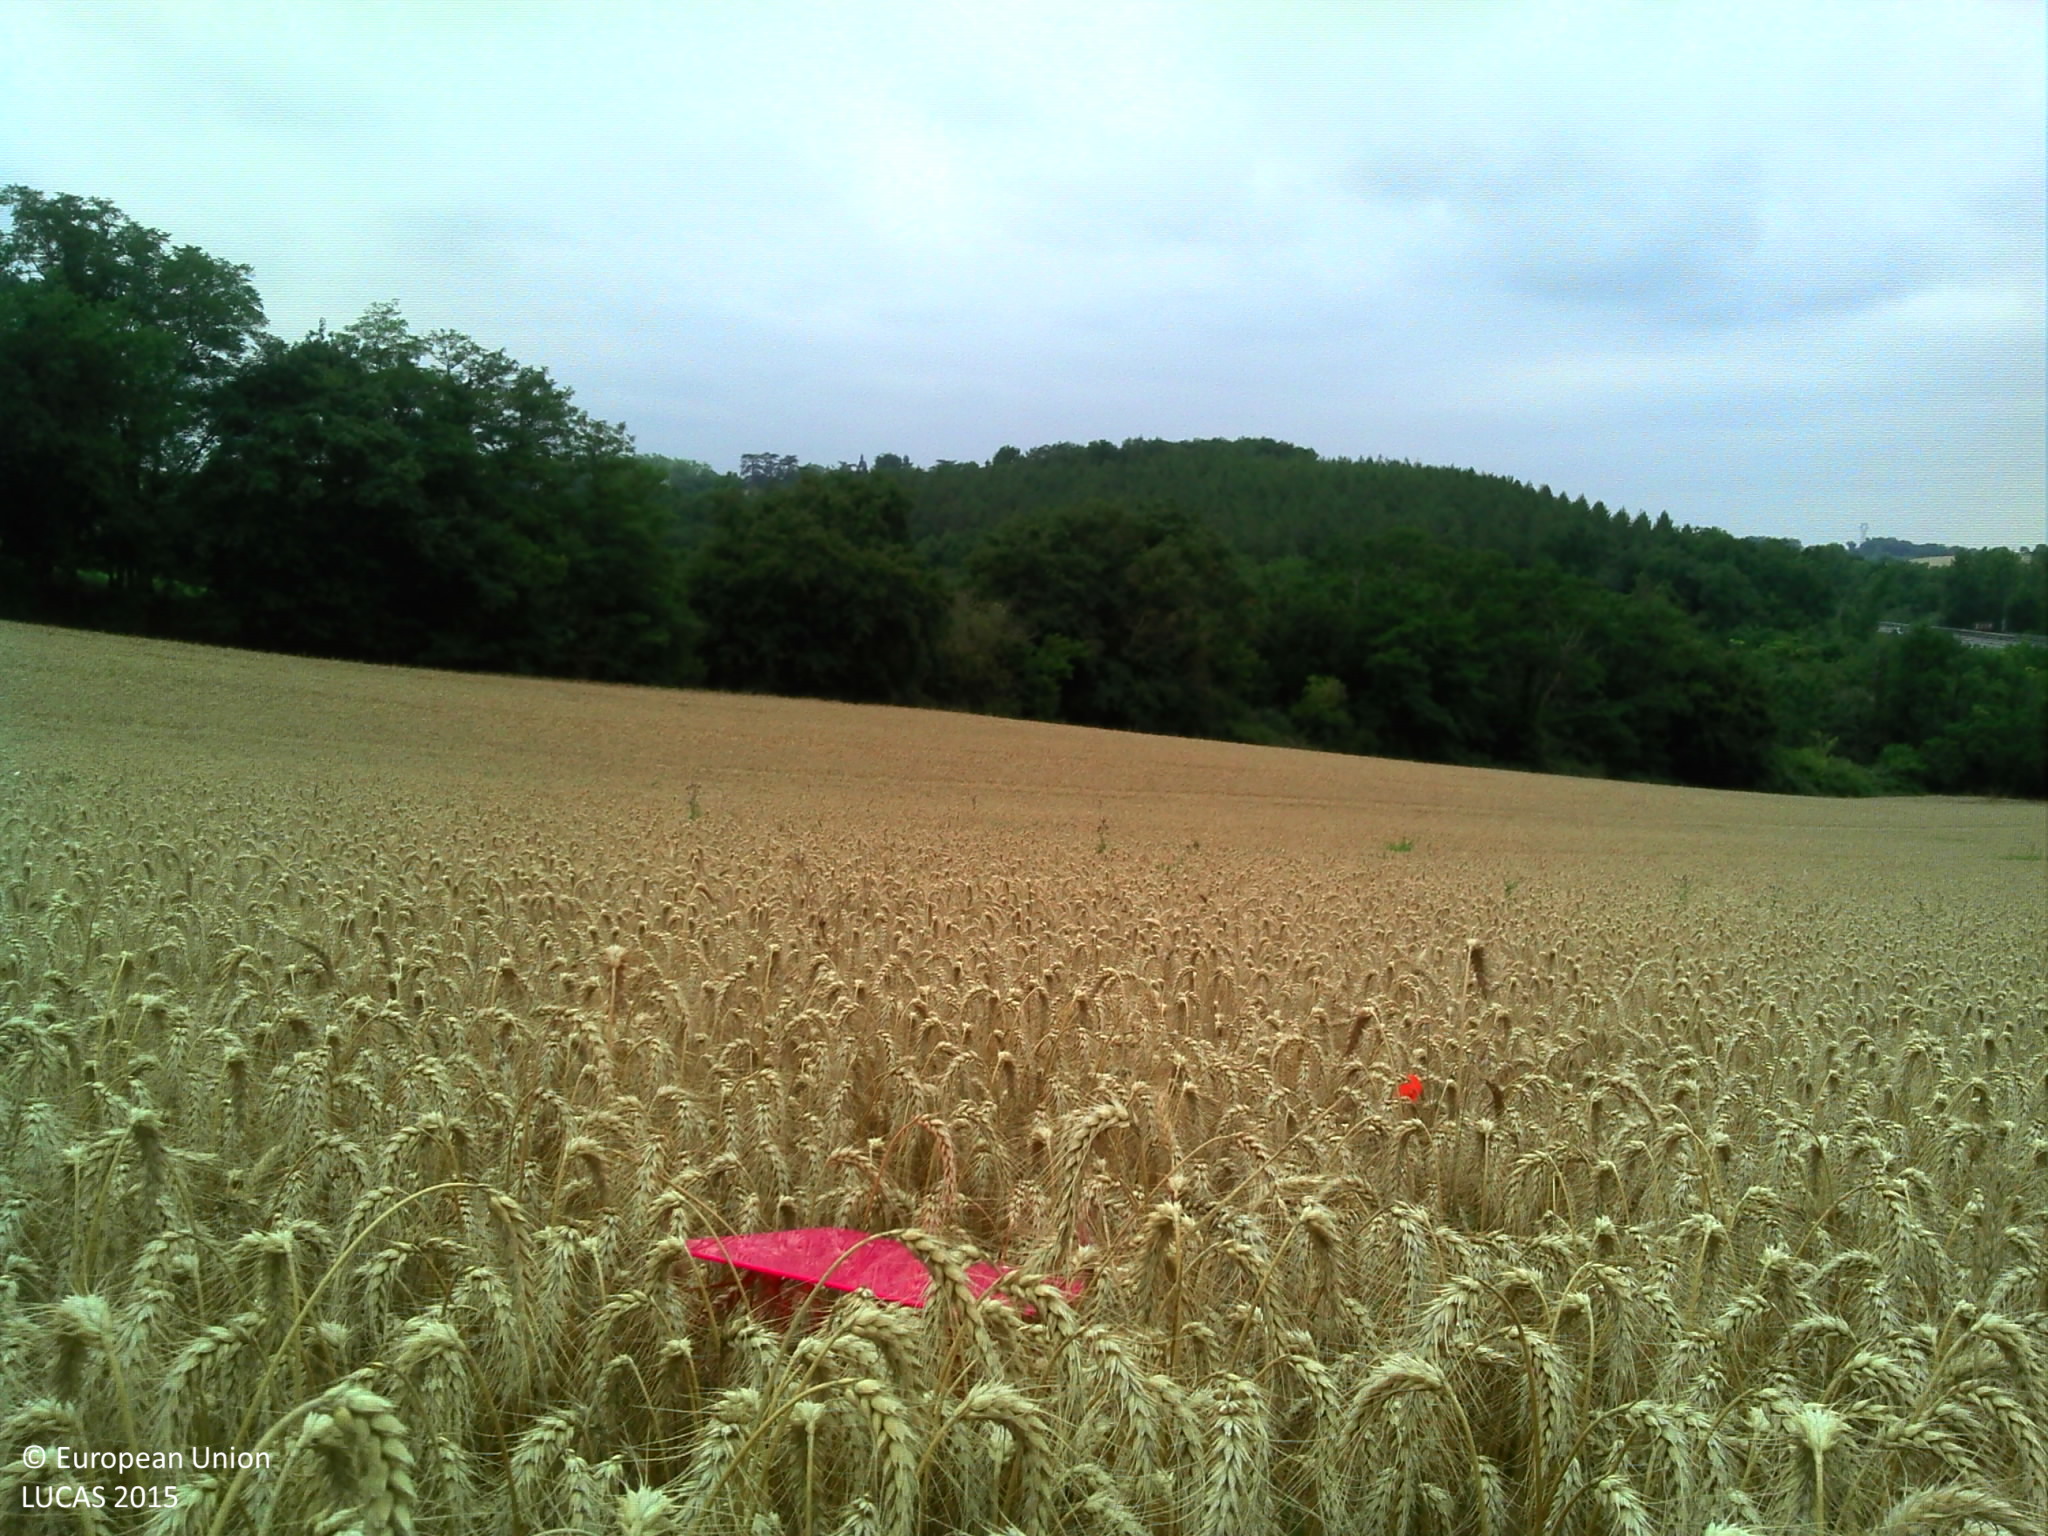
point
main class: Cropland
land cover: Durum wheat
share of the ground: > 75 %
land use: Agriculture (excluding fallow land and kitchen gardens)
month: June
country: FR
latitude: 44.0586
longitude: 0.8970
